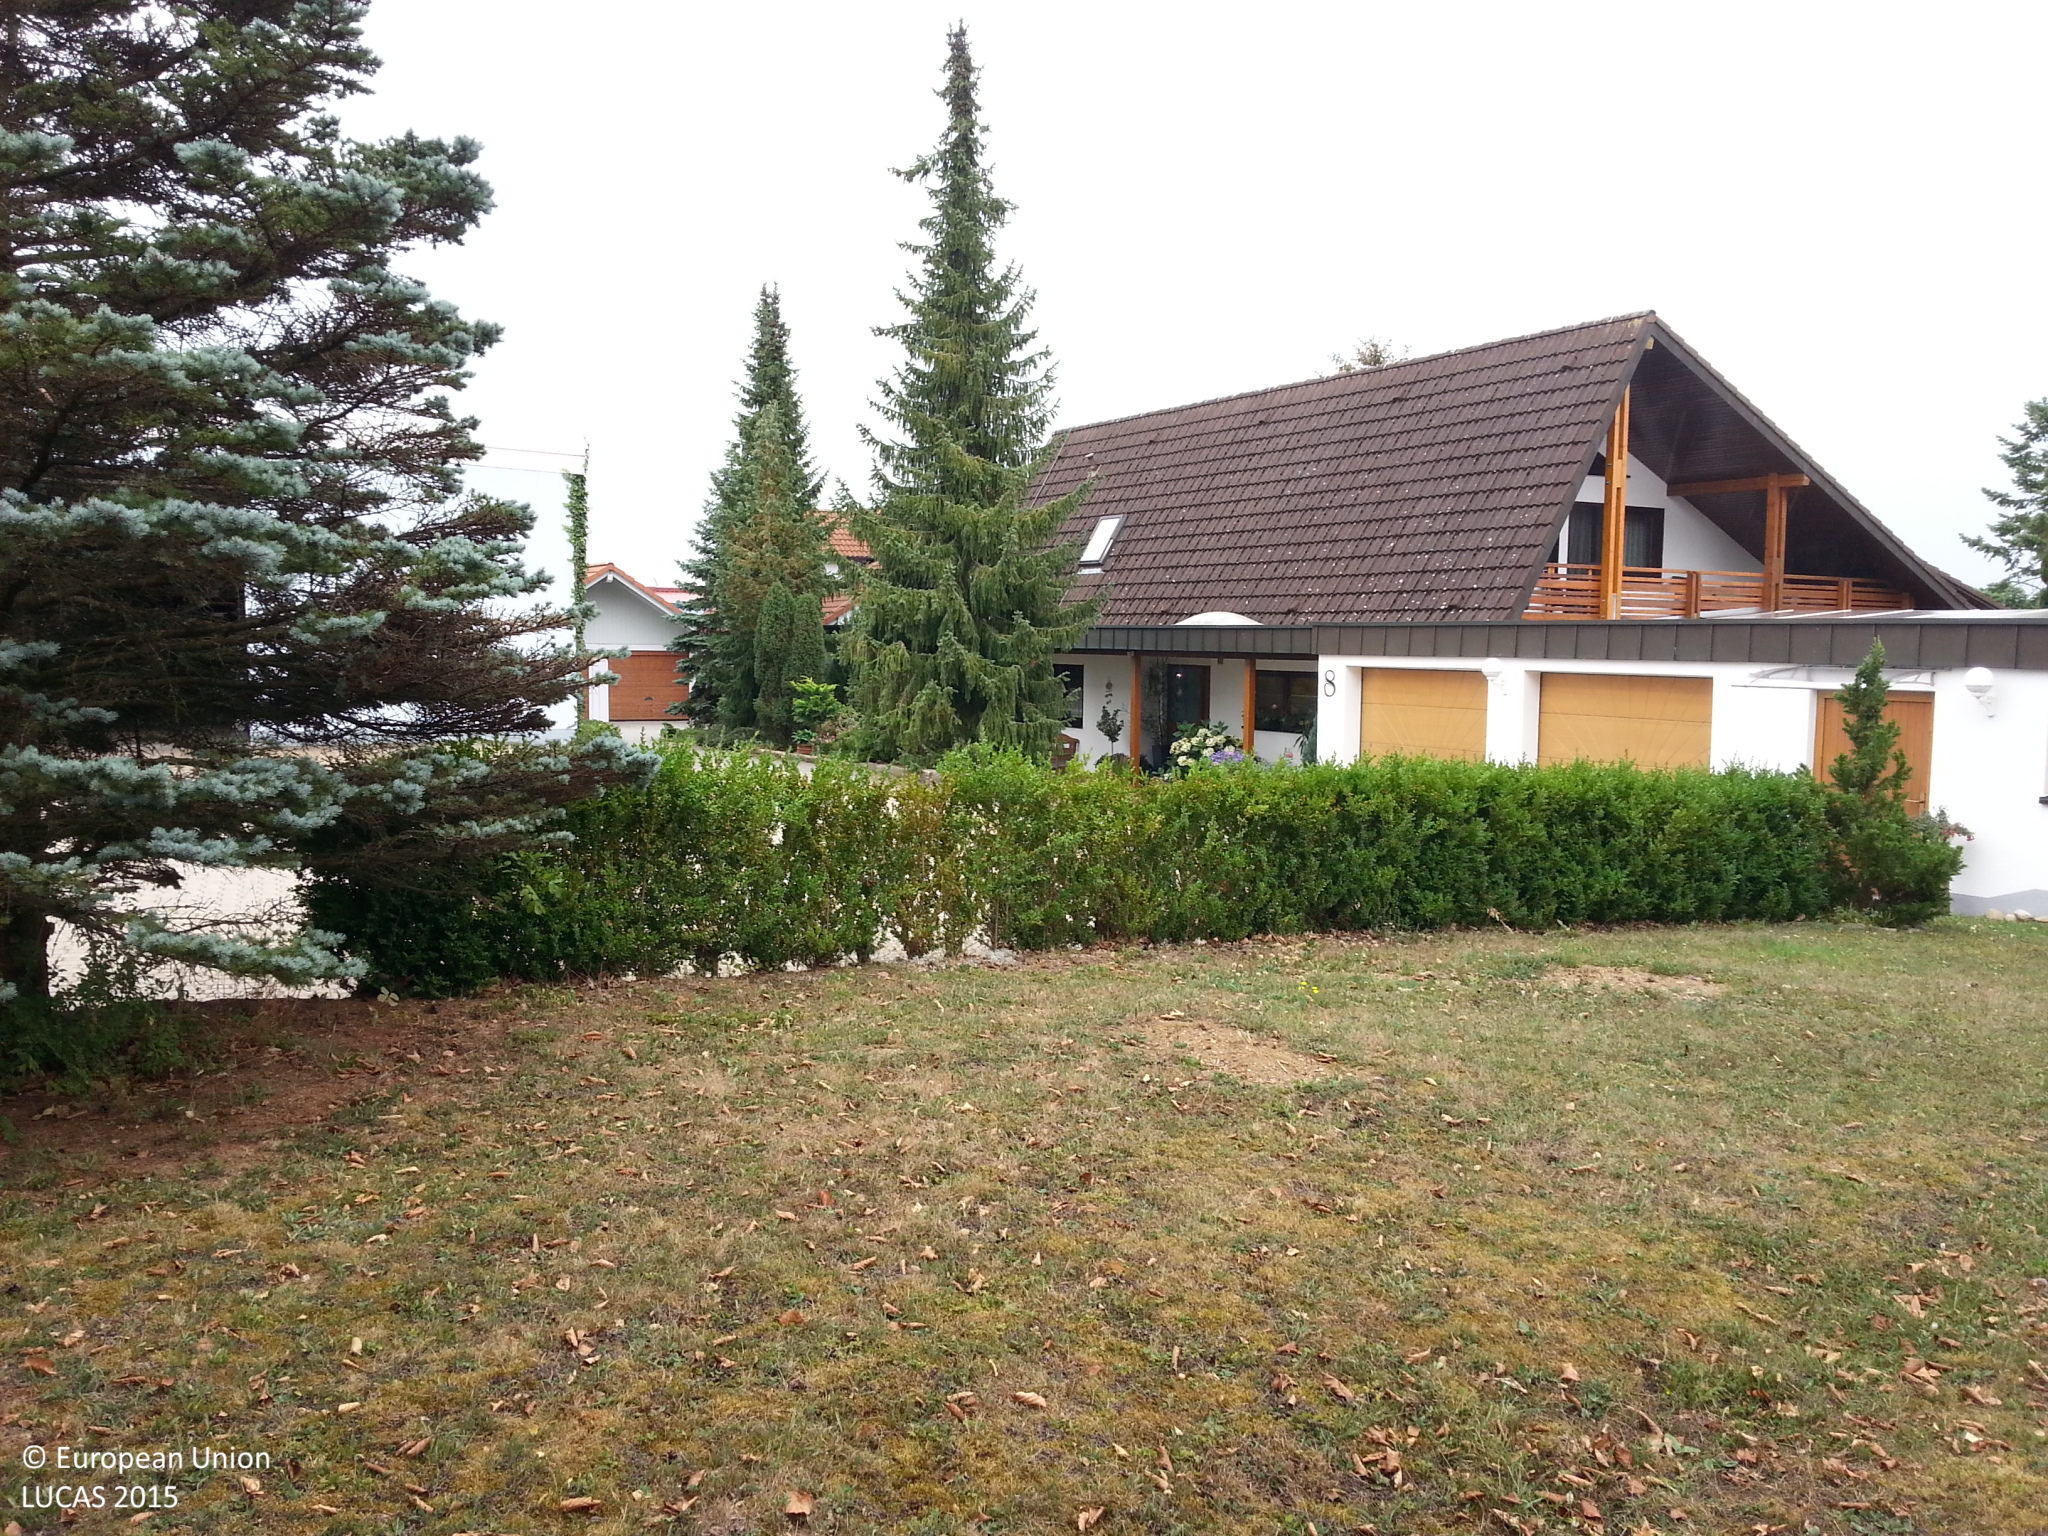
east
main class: Woodland
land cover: Broadleaved woodland
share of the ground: 50 - 75 %
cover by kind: broadleaved forest trees 70 %, herbaceous plants 30 %
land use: Residential
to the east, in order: Broadleaved woodland; Artificial constructions in urban areas; Grassland without tree/shrub cover
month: September
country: DE
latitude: 49.2490
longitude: 9.9313
